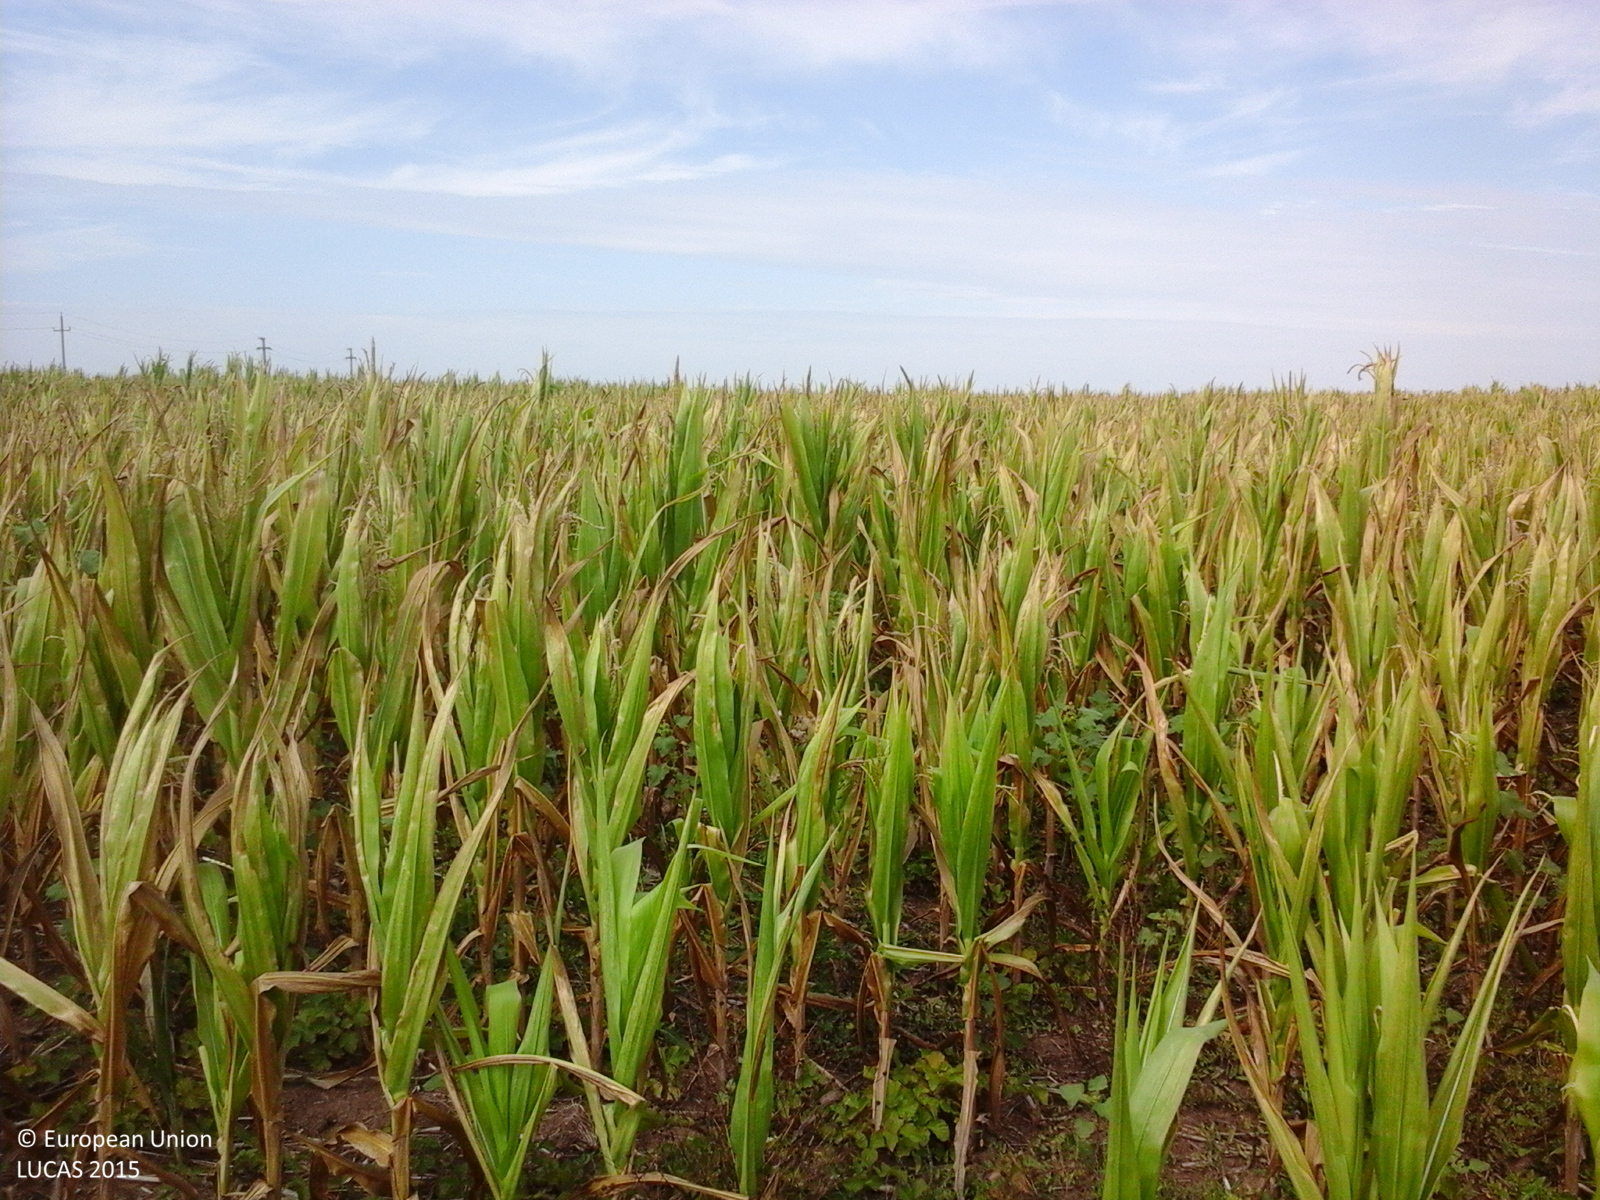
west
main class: Cropland
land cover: Maize
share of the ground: > 75 %
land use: Agriculture (excluding fallow land and kitchen gardens)
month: August
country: RO
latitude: 46.1286
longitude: 21.3326
